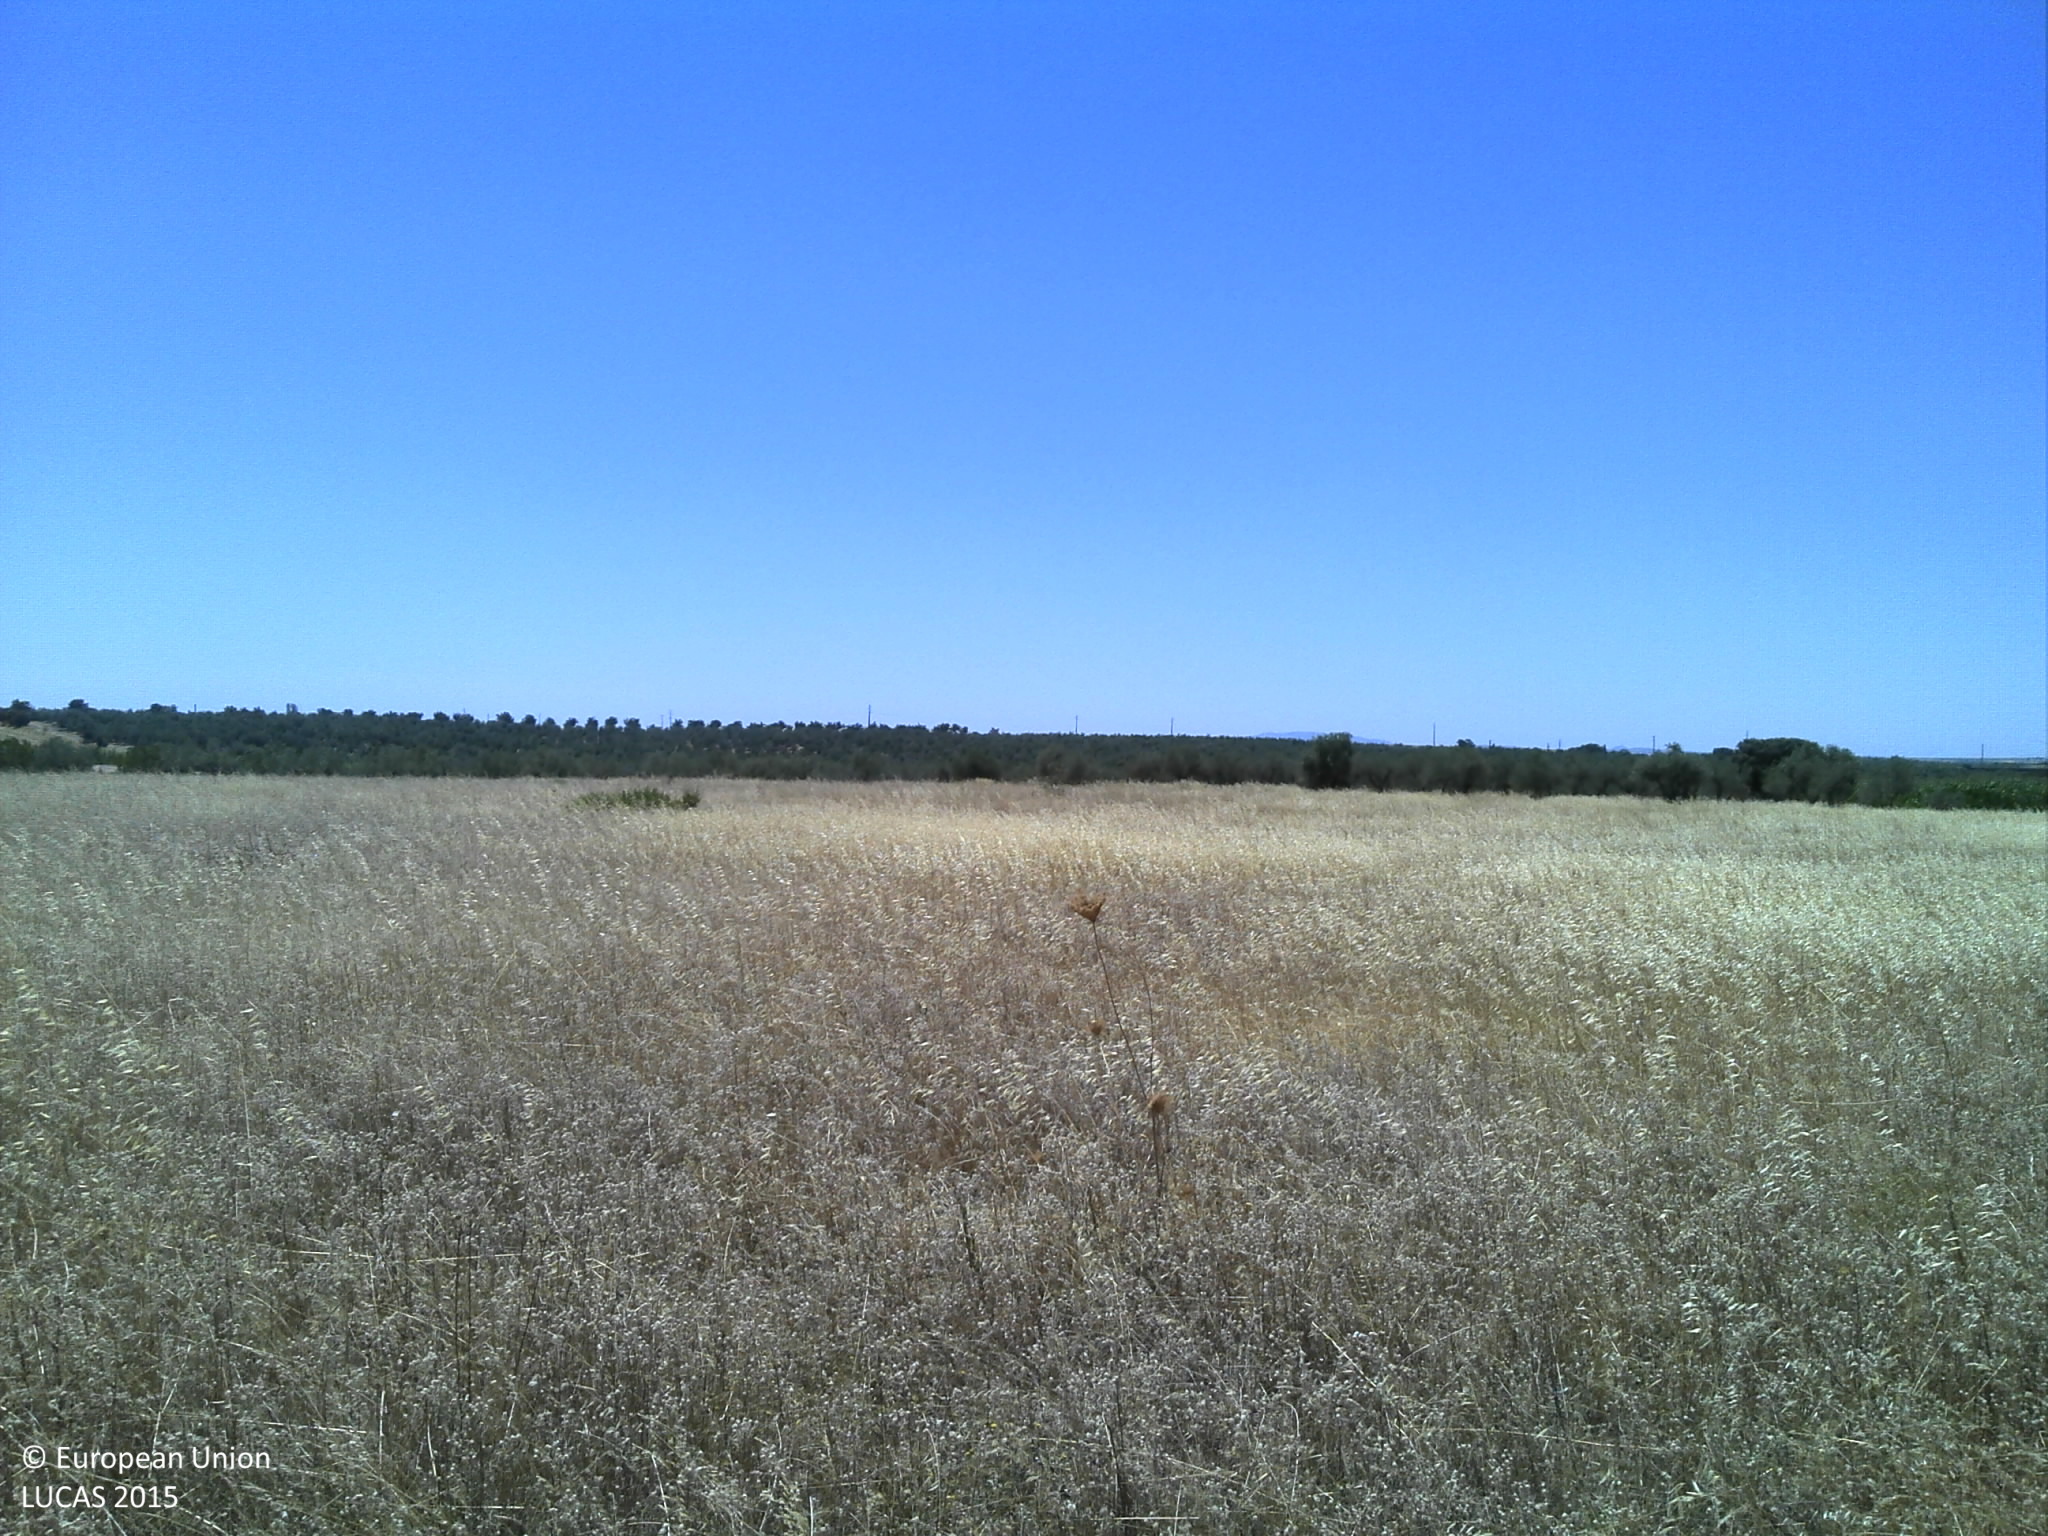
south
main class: Grassland
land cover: Spontaneously vegetated surfaces
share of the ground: 50 - 75 %
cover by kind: herbaceous plants 75 %, unconsolidated bare surface 25 %
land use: Fallow land
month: July
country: PT
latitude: 38.9653
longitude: -7.0501
